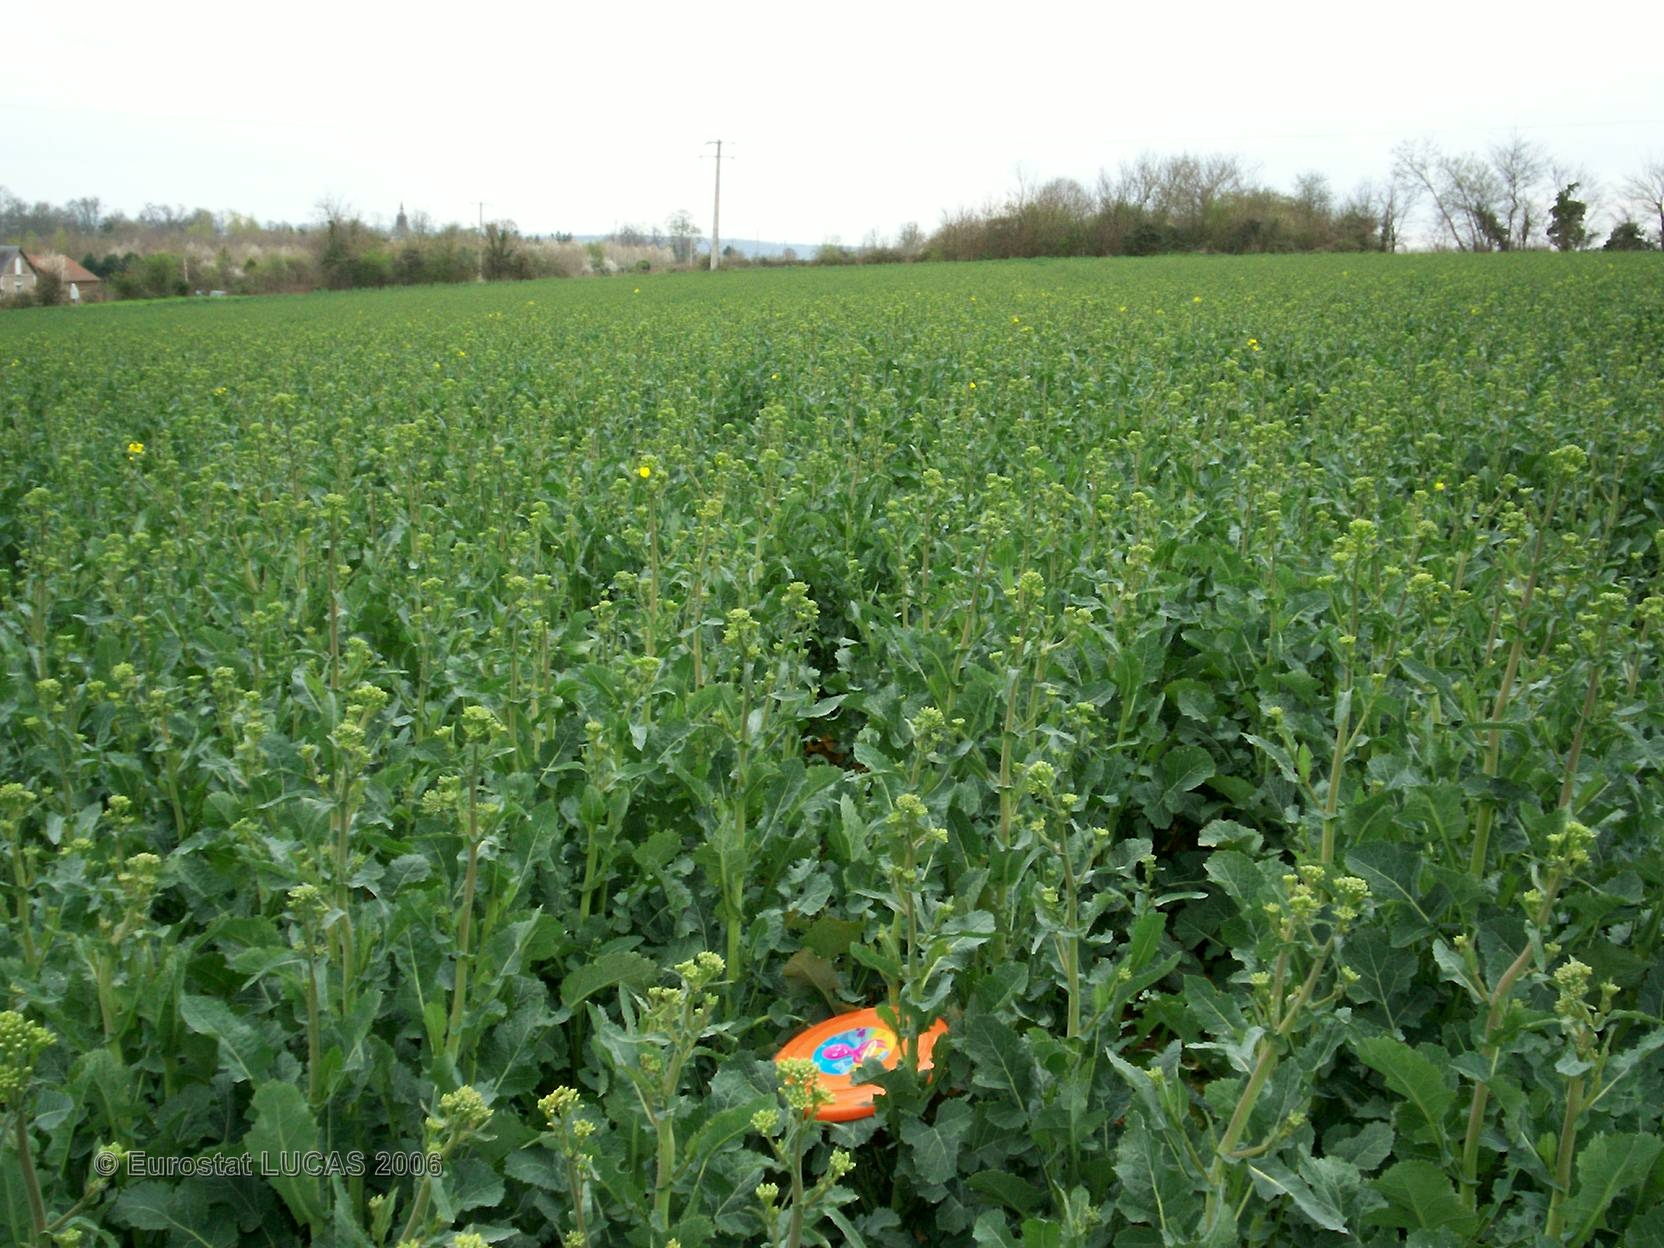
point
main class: Cropland
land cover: Rape and turnip rape
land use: Agriculture (excluding fallow land and kitchen gardens)
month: April
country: FR
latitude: 48.9935
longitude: -0.0768
